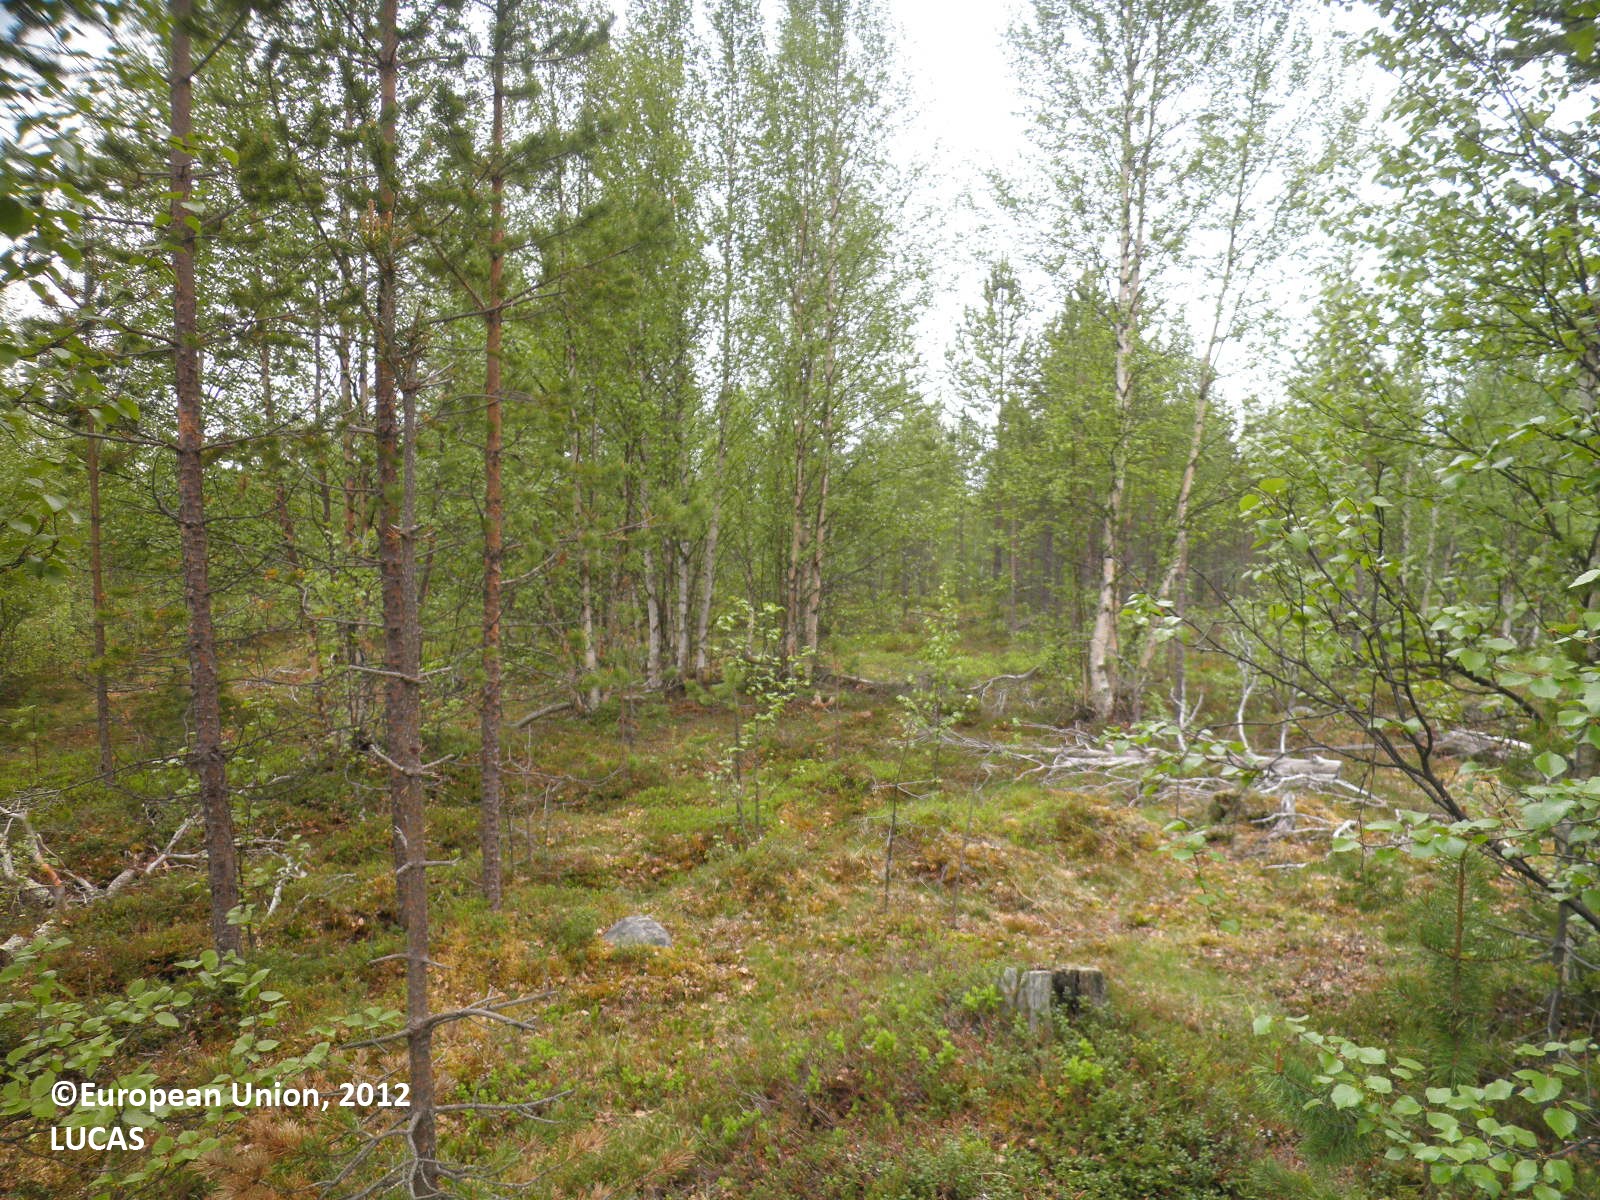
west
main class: Woodland
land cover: Pine dominated mixed woodland
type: boreal forest
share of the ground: 25 - 50 %
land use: Forestry
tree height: < 5 m
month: June
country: FI
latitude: 67.8407
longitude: 25.6557
